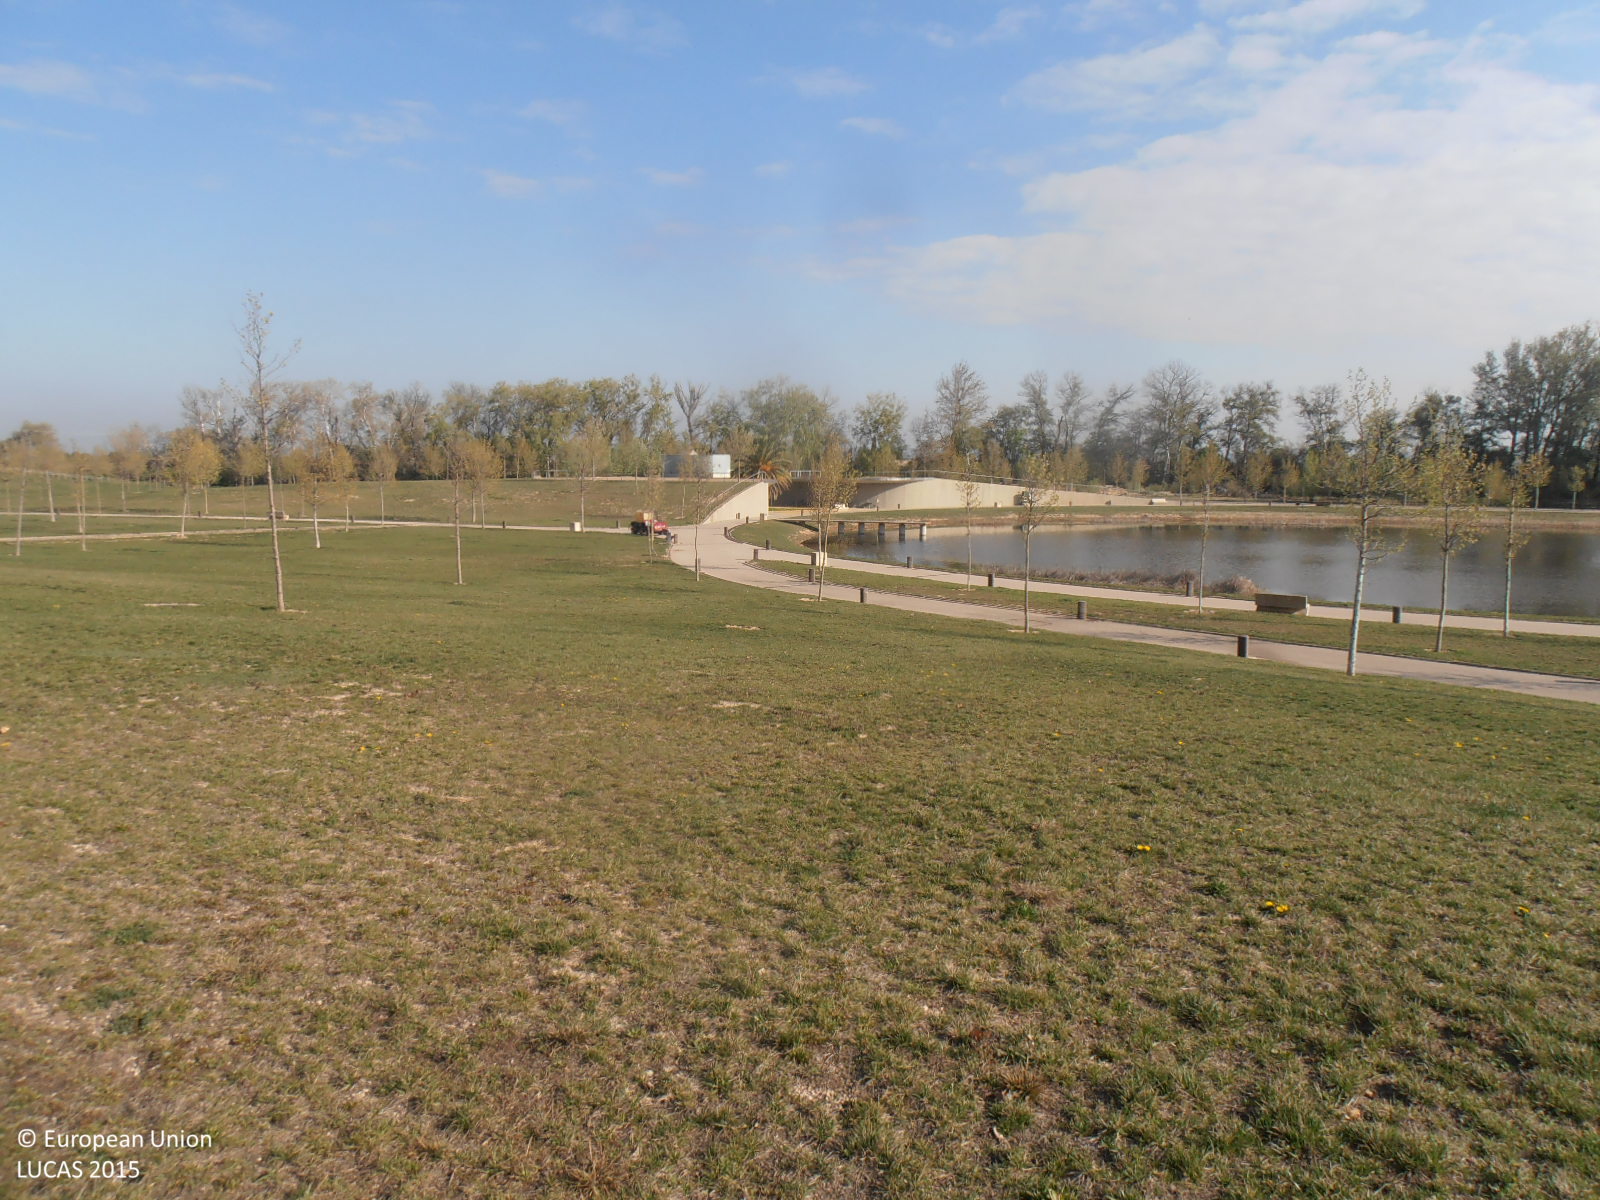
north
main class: Grassland
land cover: Grassland with sparse tree/shrub cover
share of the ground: > 75 %
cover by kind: herbaceous plants 95 %, broadleaved forest trees 5 %
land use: Sport
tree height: < 5 m
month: April
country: ES
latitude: 41.6539
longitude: -0.9859
